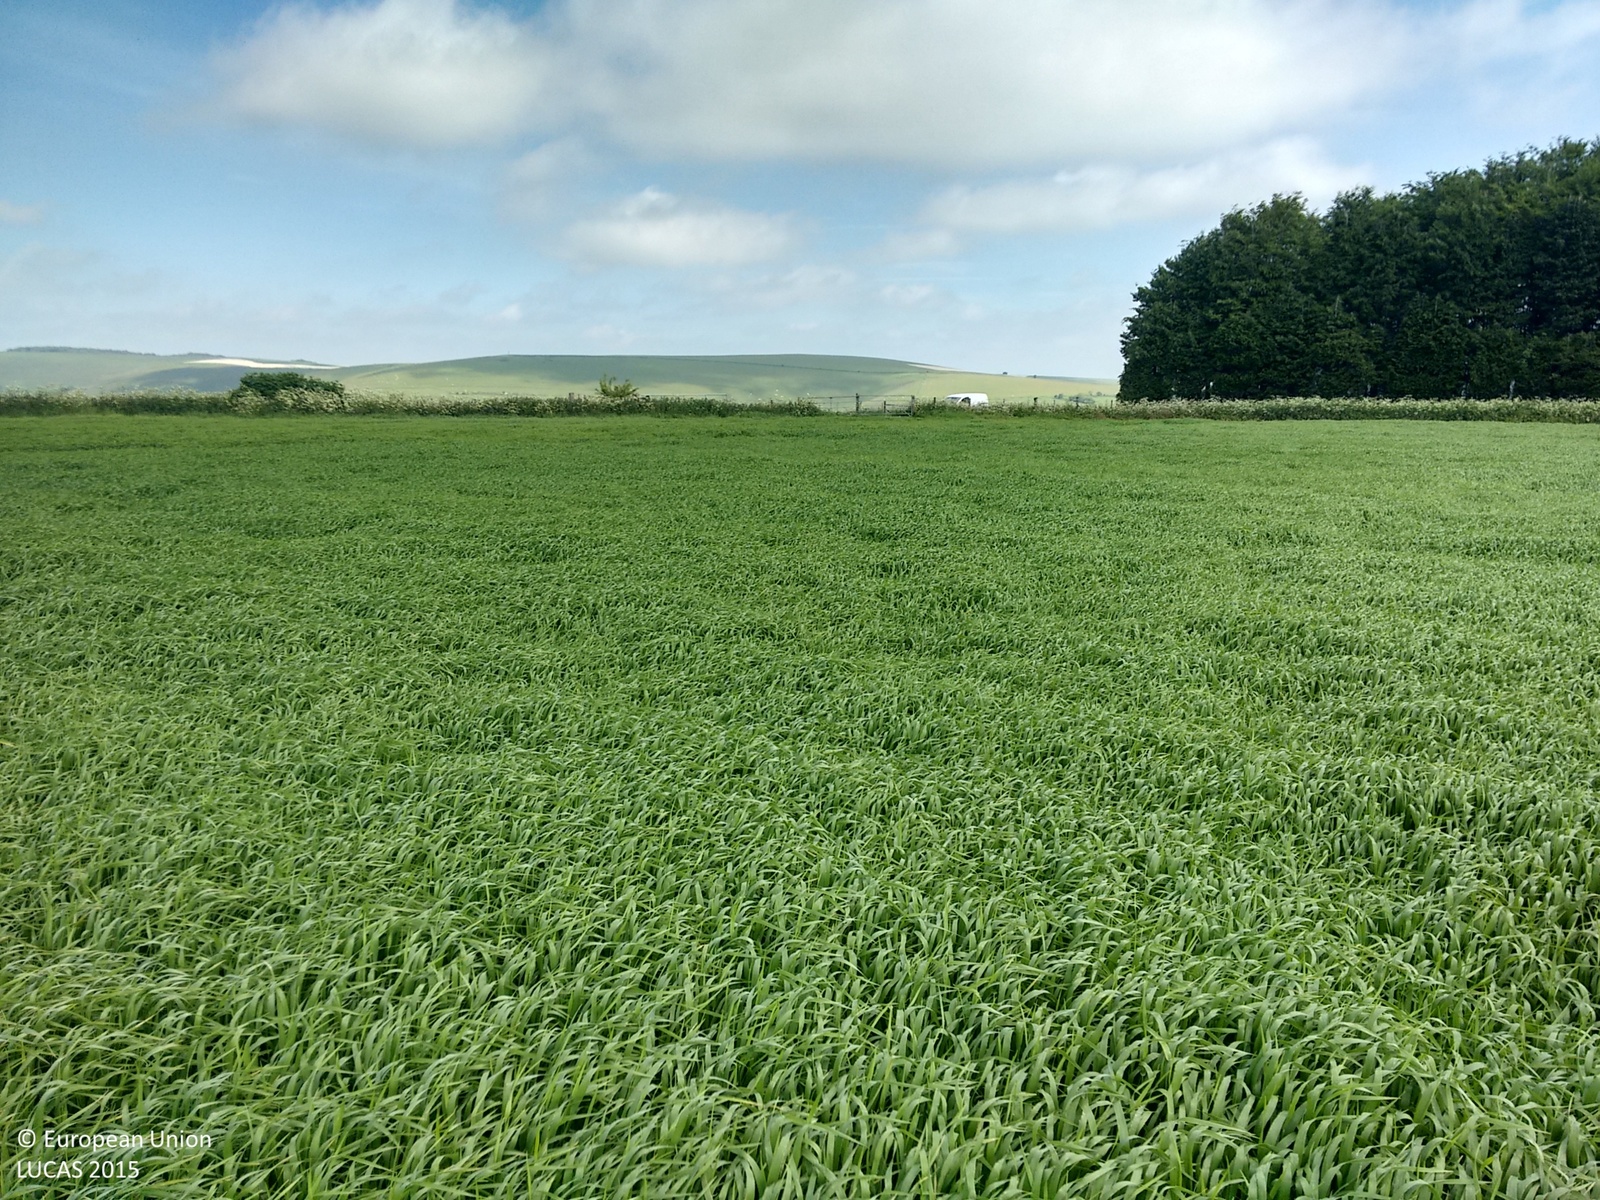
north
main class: Cropland
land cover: Barley
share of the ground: > 75 %
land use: Agriculture (excluding fallow land and kitchen gardens)
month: June
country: GB
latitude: 51.1246
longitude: -2.2210
